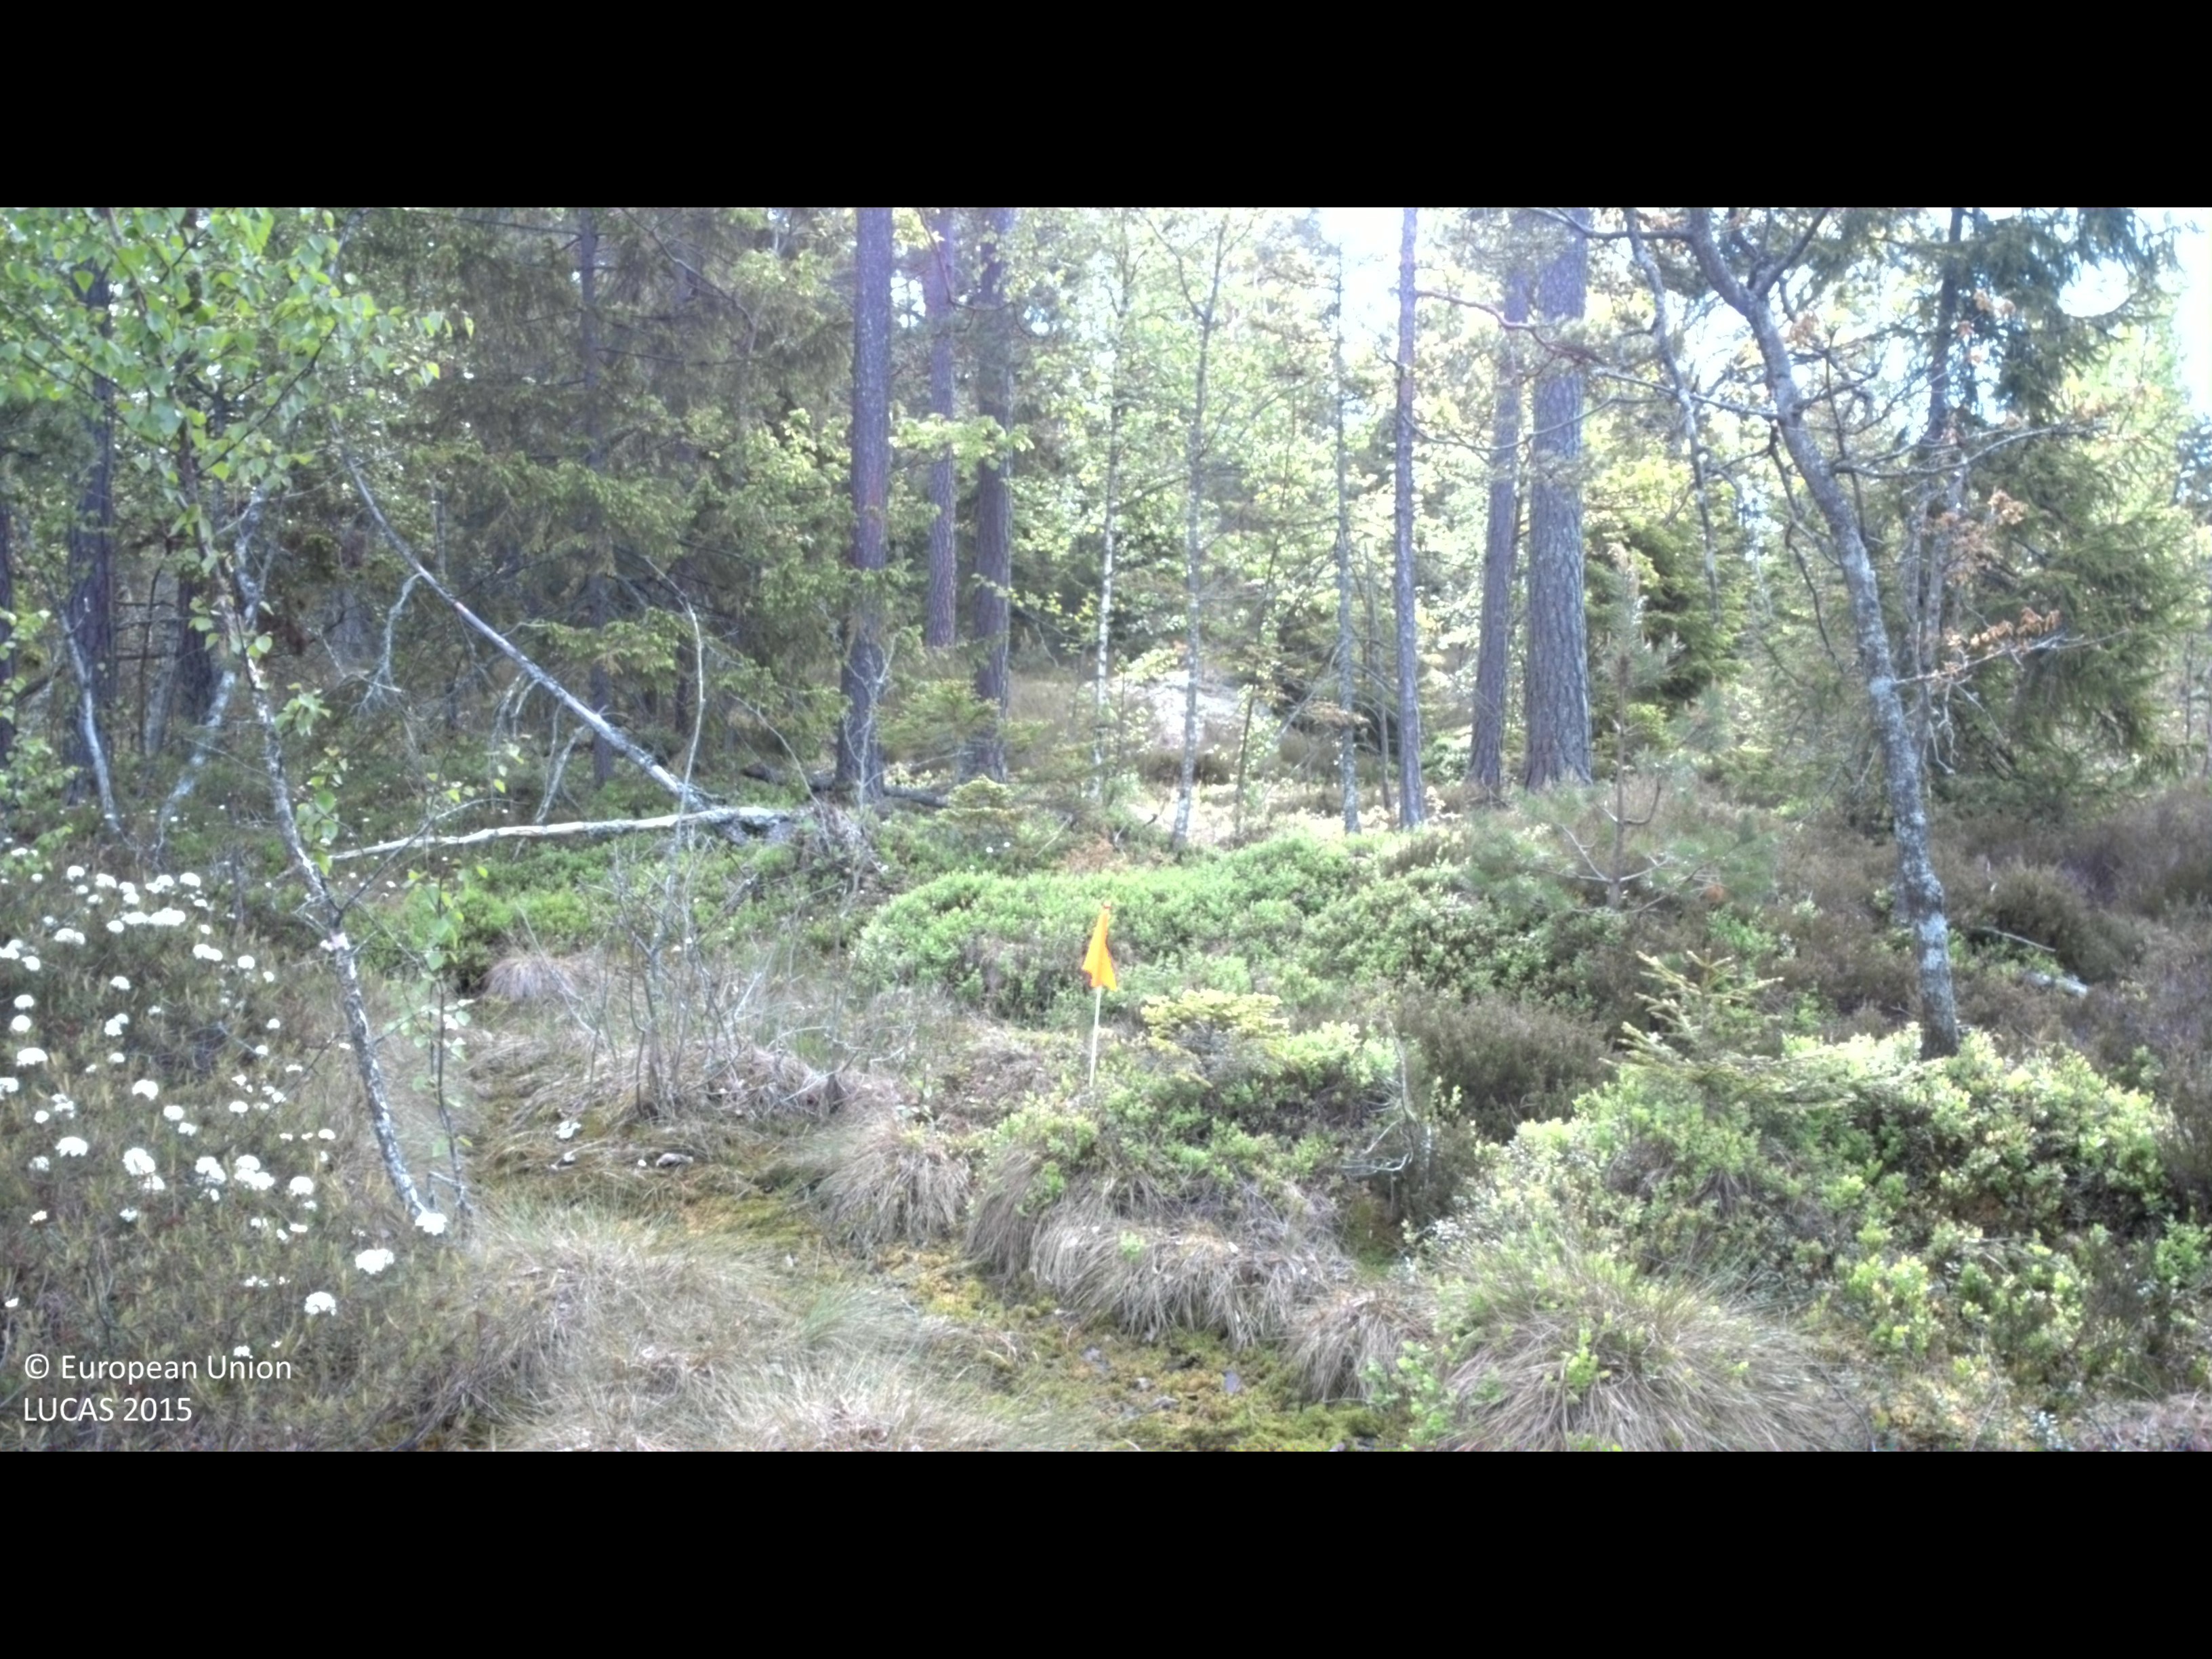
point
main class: Woodland
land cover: Pine dominated mixed woodland
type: boreal forest
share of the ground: > 75 %
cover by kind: coniferous forest trees 60 %, broadleaved forest trees 25 %, shrubs 15 %
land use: Forestry
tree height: > 5 m
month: May
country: SE
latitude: 57.3242
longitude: 16.4598
